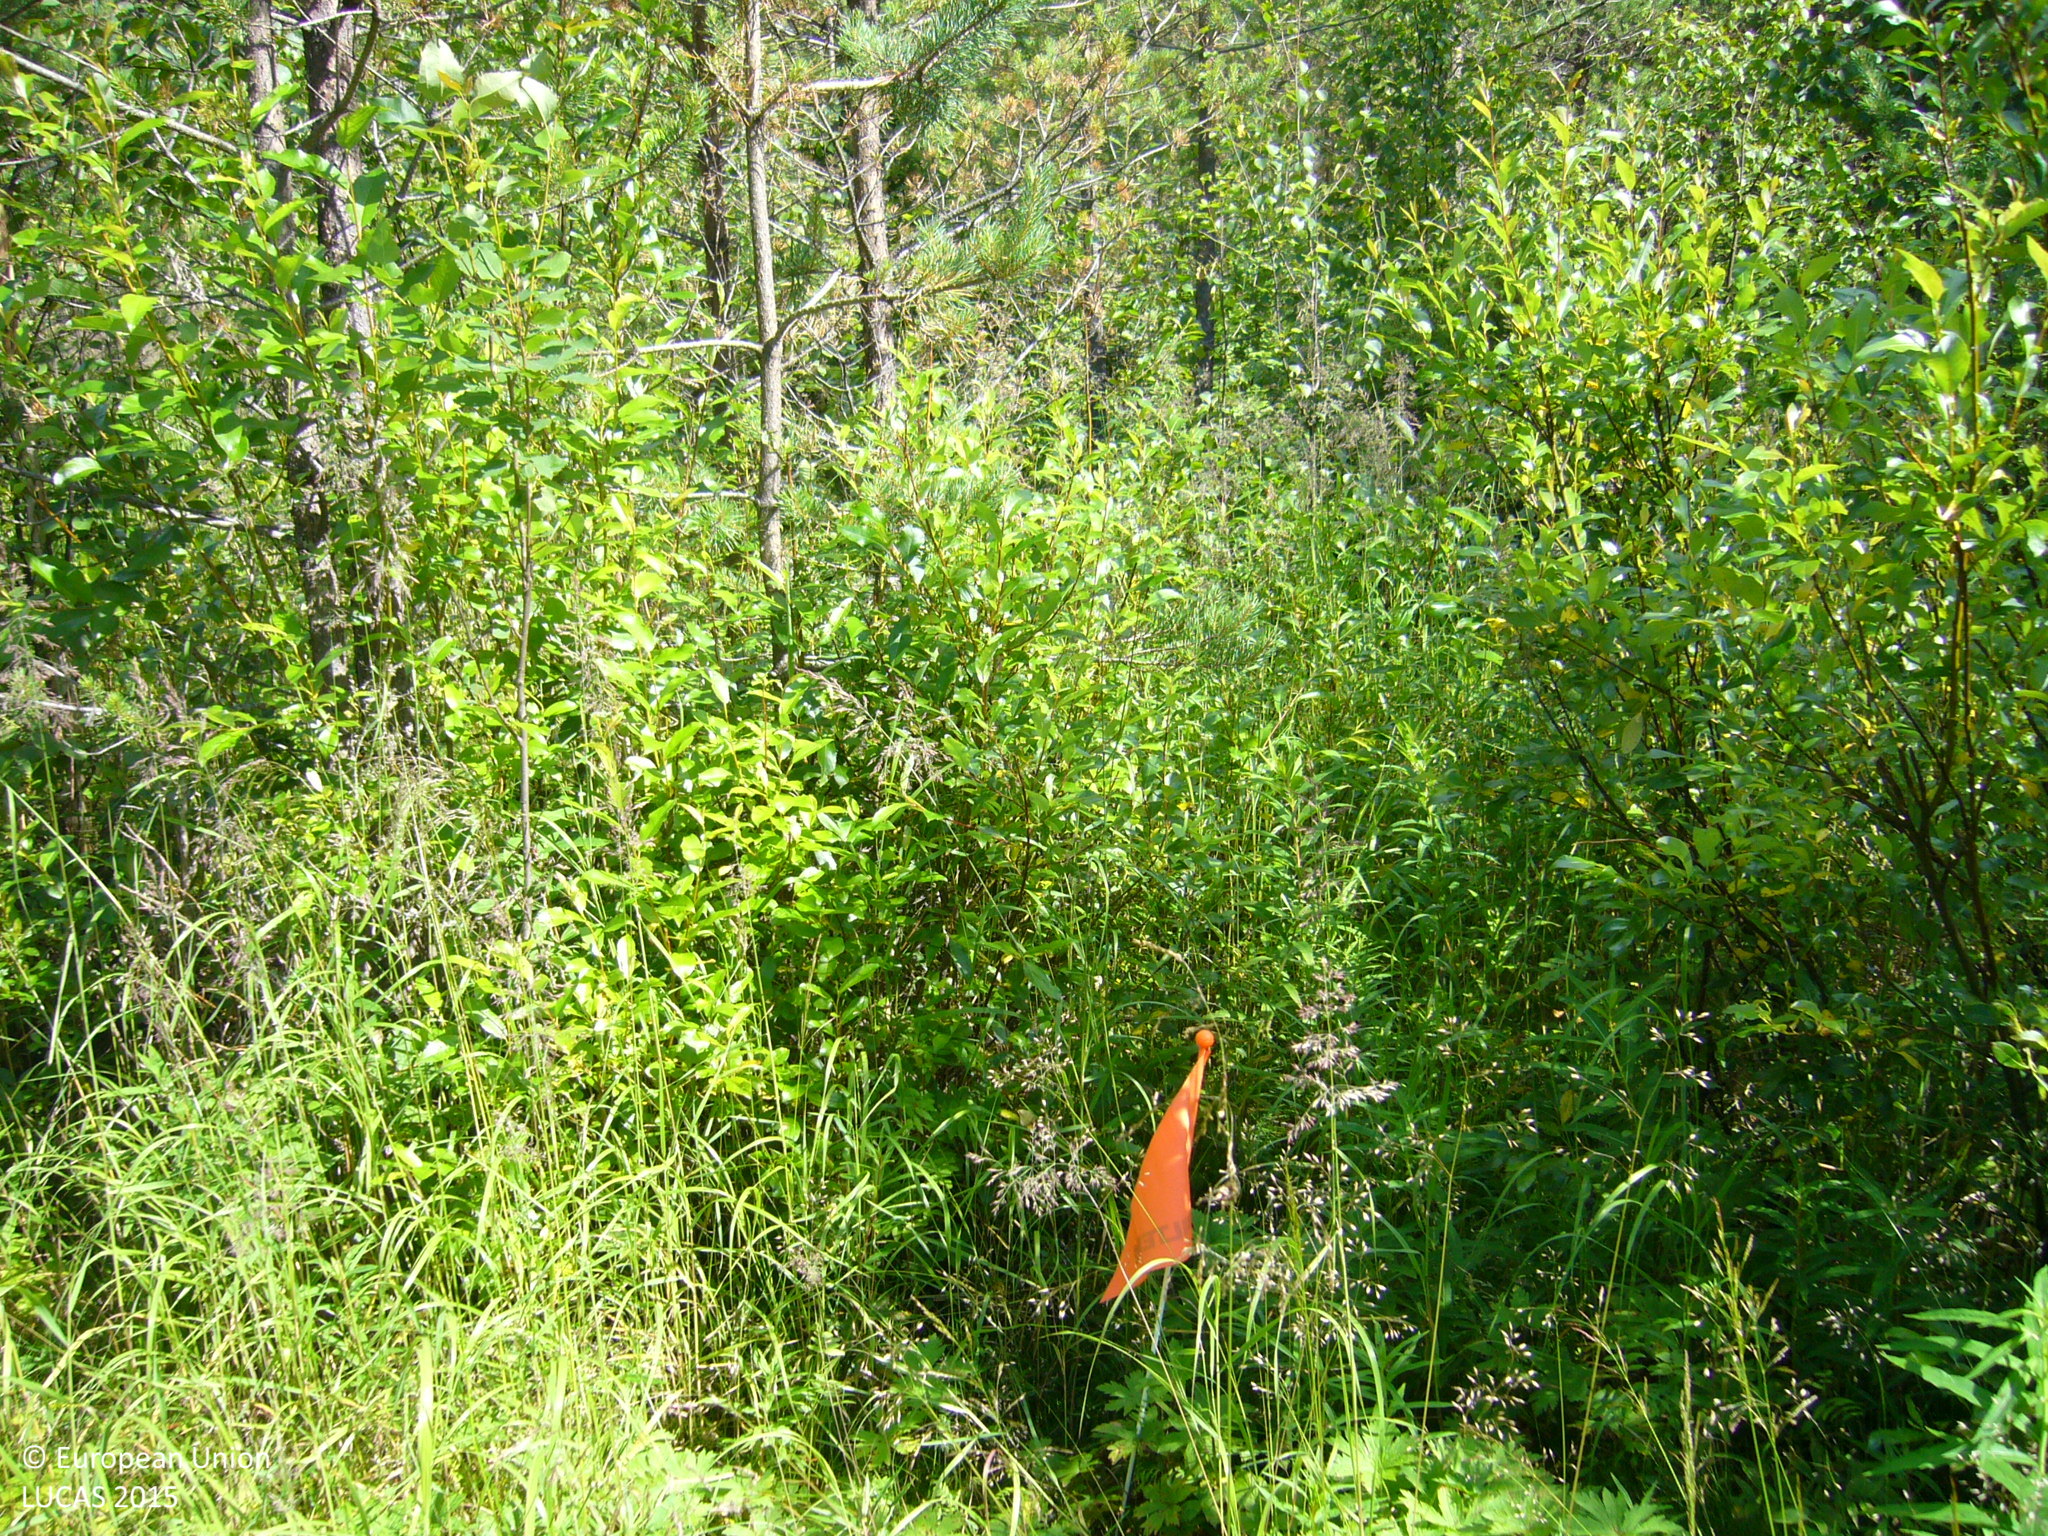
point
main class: Woodland
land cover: Pine dominated mixed woodland
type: boreal forest
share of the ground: 50 - 75 %
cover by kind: coniferous forest trees 40 %, broadleaved forest trees 30 %, herbaceous plants 30 %
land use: Forestry
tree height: > 5 m
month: July
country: FI
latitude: 63.9787
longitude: 26.0658
